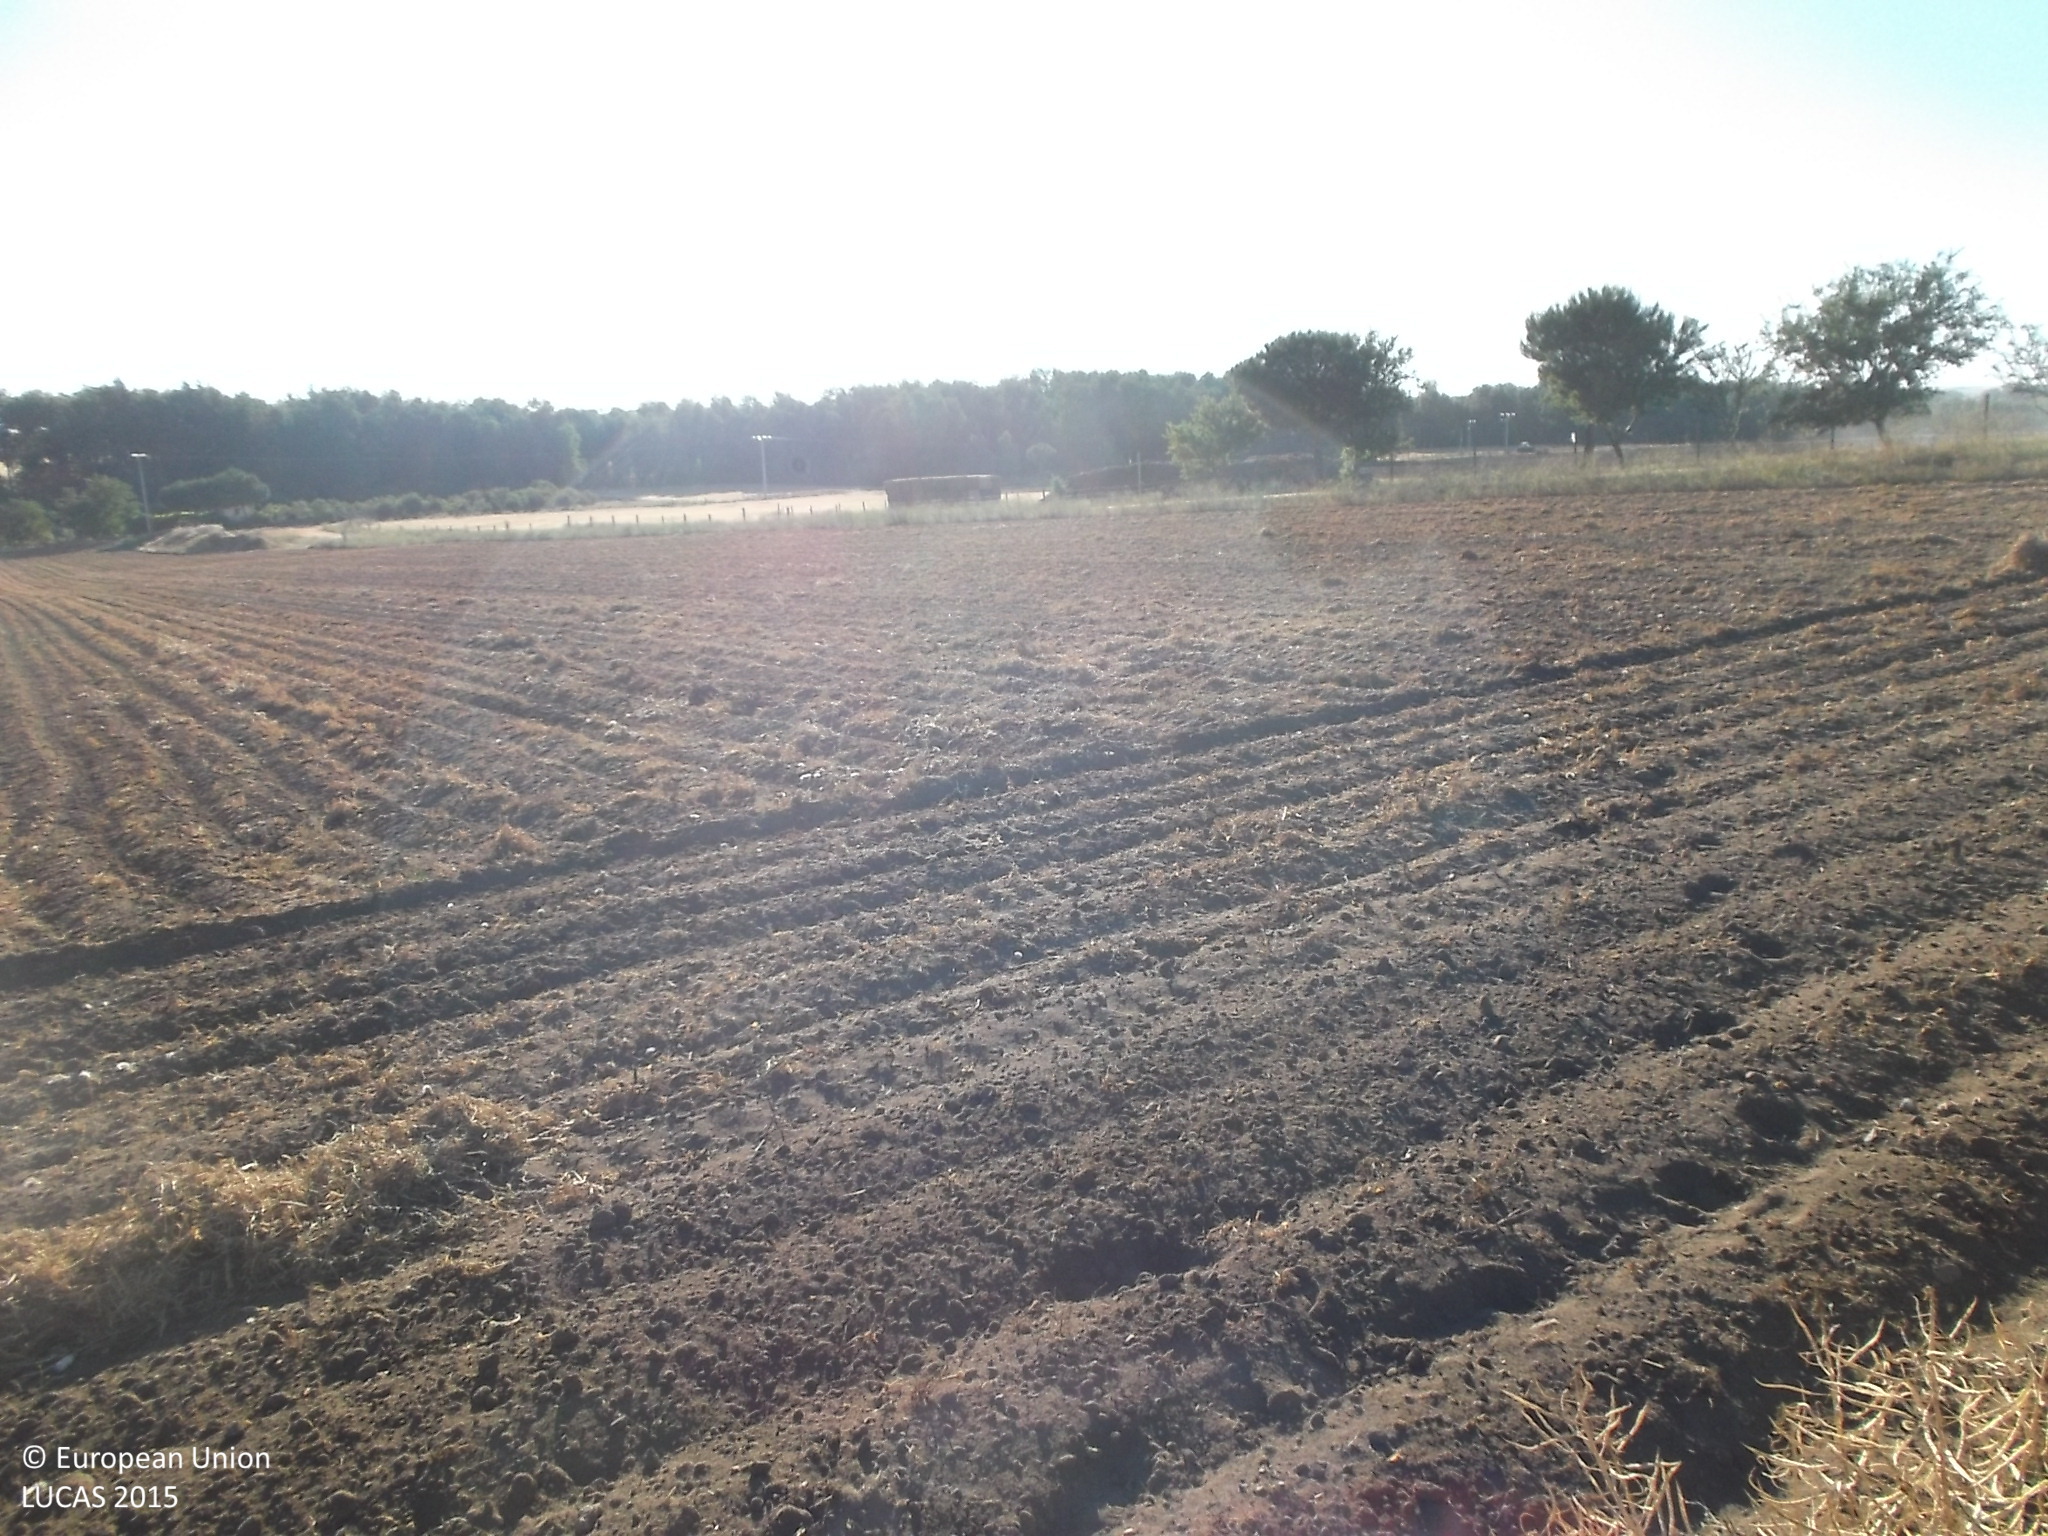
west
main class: Cropland
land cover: Rape and turnip rape
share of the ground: > 75 %
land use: Agriculture (excluding fallow land and kitchen gardens)
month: June
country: ES
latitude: 41.2749
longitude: -5.3444
